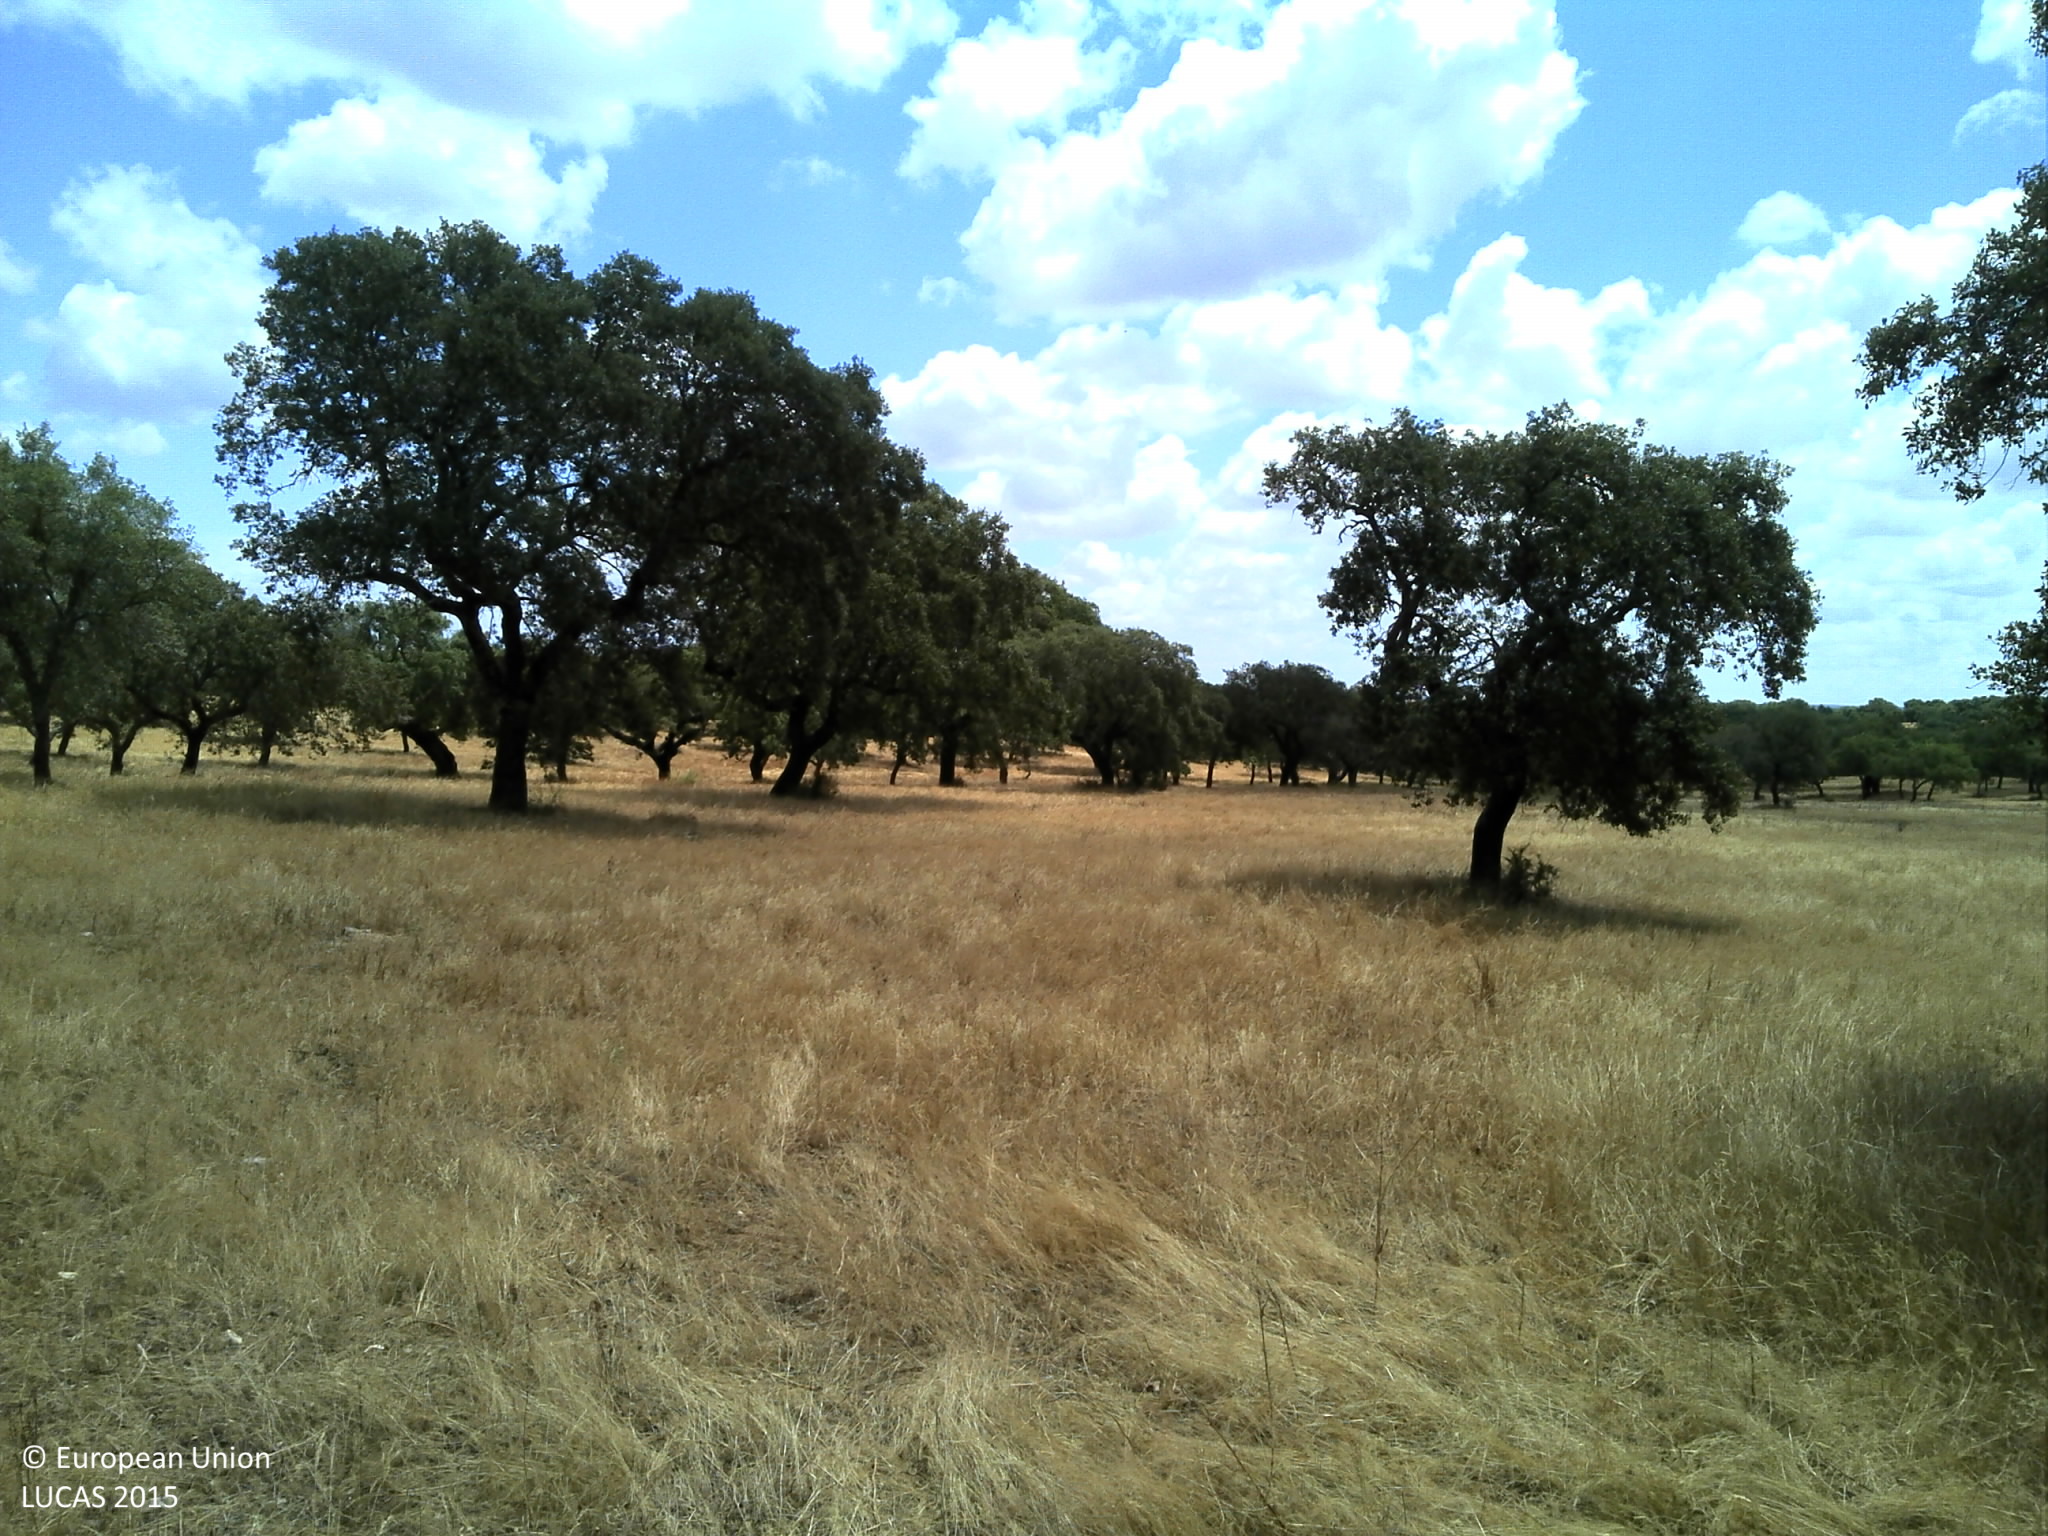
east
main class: Woodland
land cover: Broadleaved woodland
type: broadleaved evergreen forest
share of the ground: 25 - 50 %
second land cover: Grassland without tree/shrub cover
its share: 10 - 25 %
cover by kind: unconsolidated bare surface 55 %, broadleaved forest trees 30 %, herbaceous plants 15 %
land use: Forestry
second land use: Agriculture (excluding fallow land and kitchen gardens)
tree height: > 5 m
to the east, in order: Broadleaved woodland; Grassland without tree/shrub cover; Broadleaved woodland
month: June
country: PT
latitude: 38.4980
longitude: -8.0784
